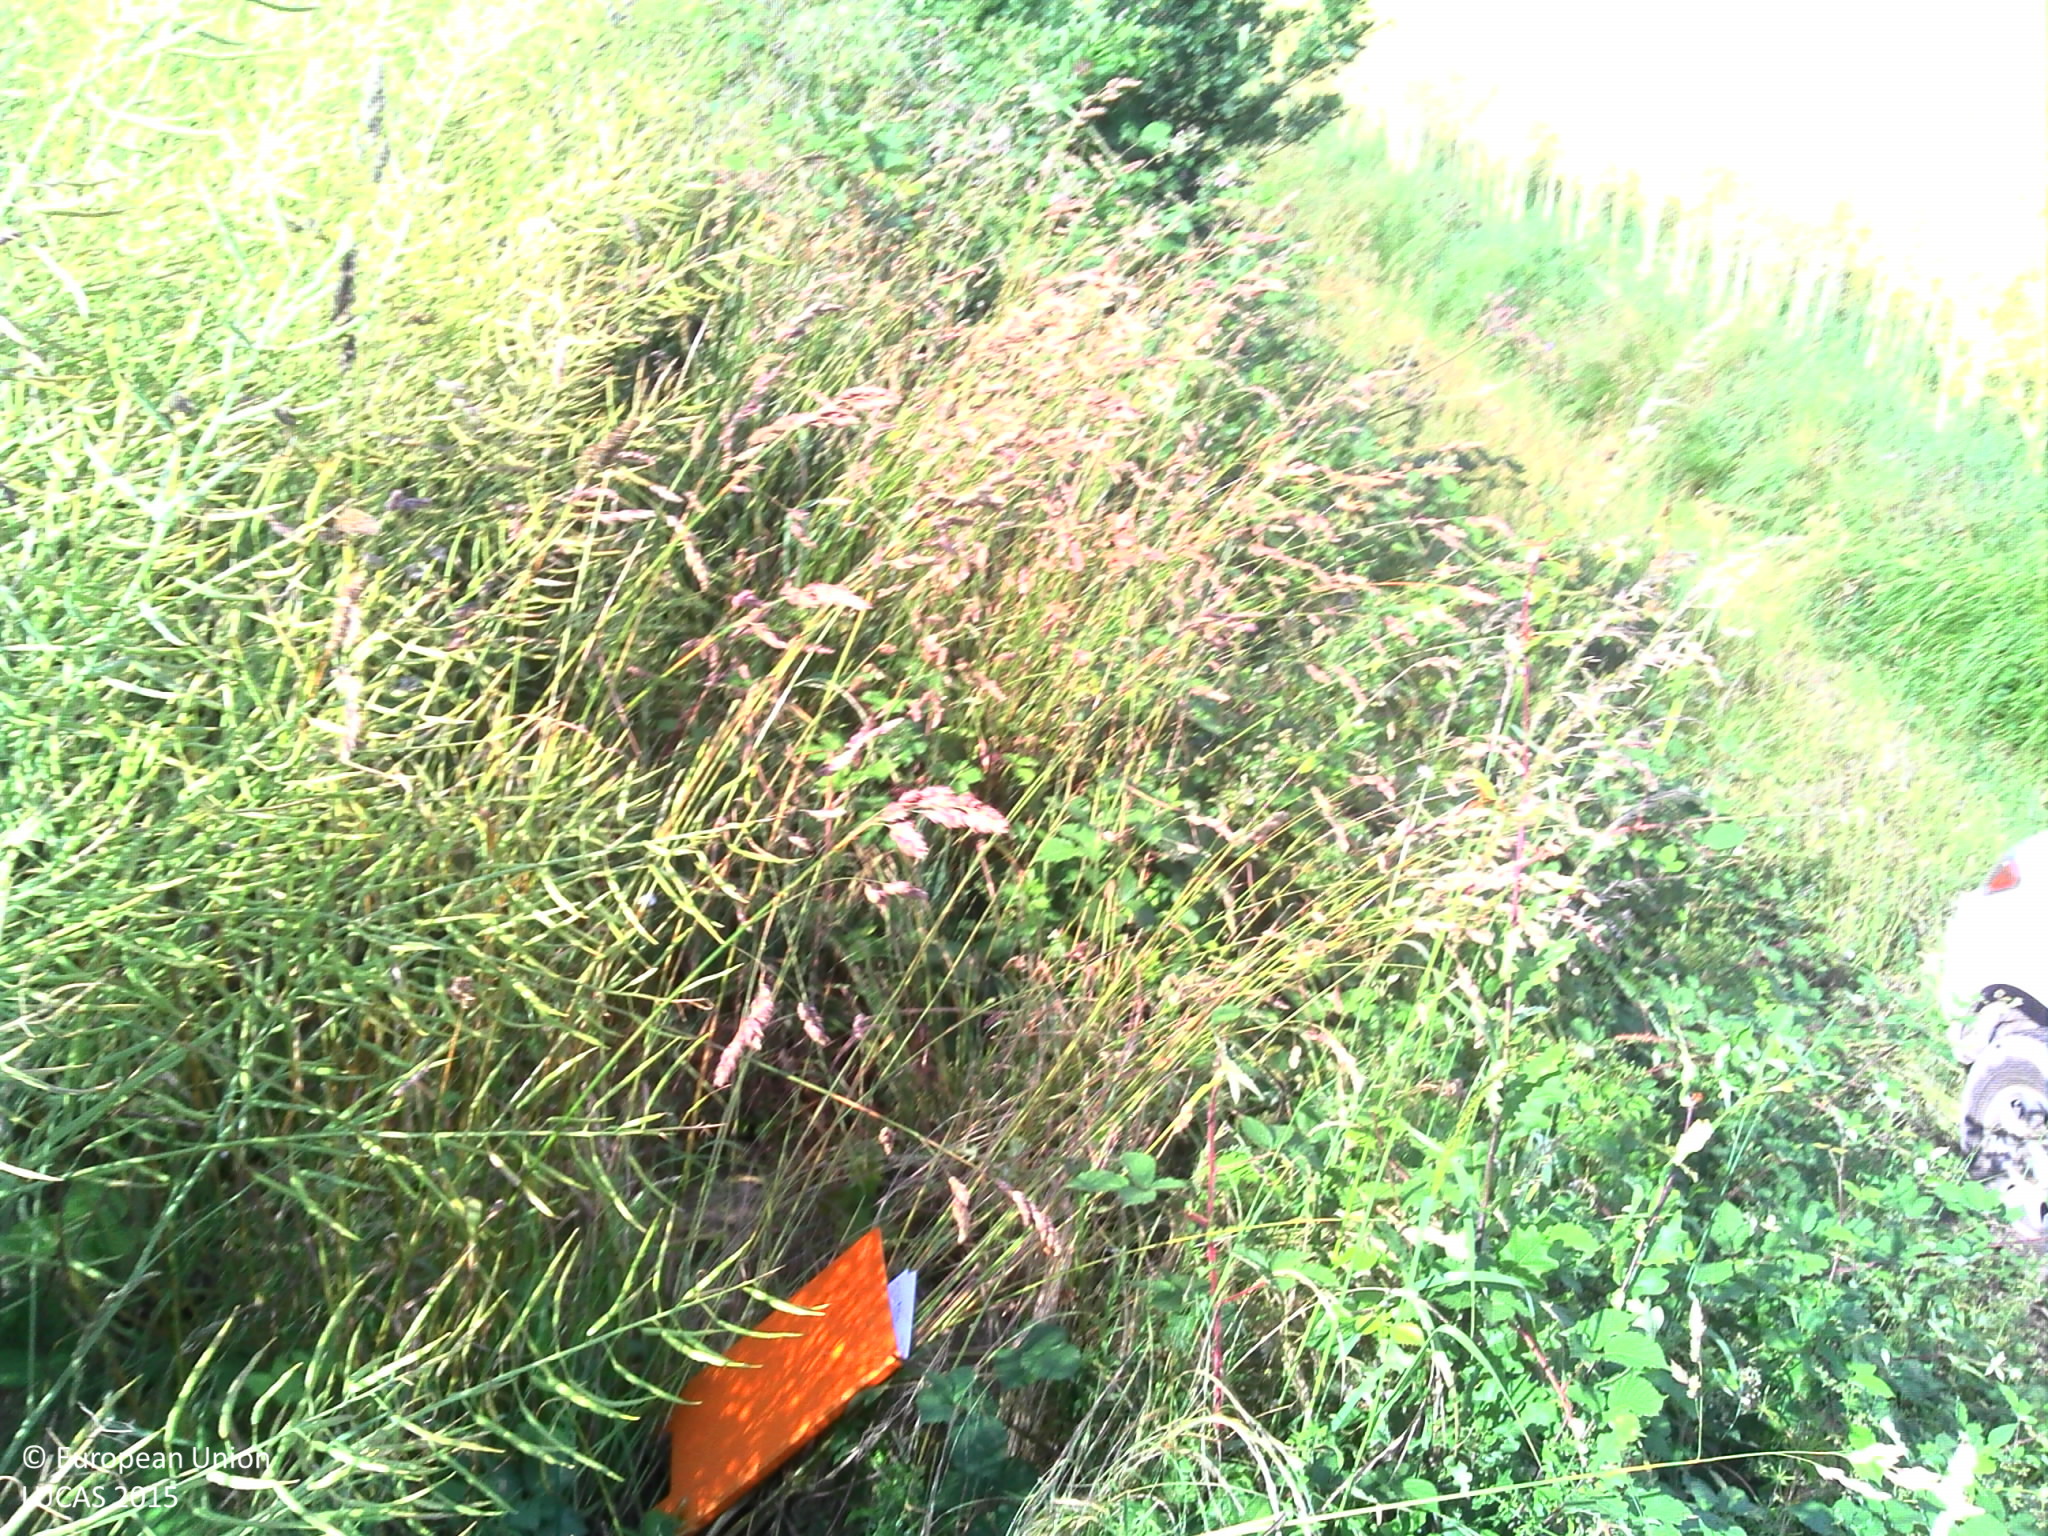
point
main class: Cropland
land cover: Rape and turnip rape
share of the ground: > 75 %
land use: Agriculture (excluding fallow land and kitchen gardens)
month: June
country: FR
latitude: 47.3597
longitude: 2.5916
